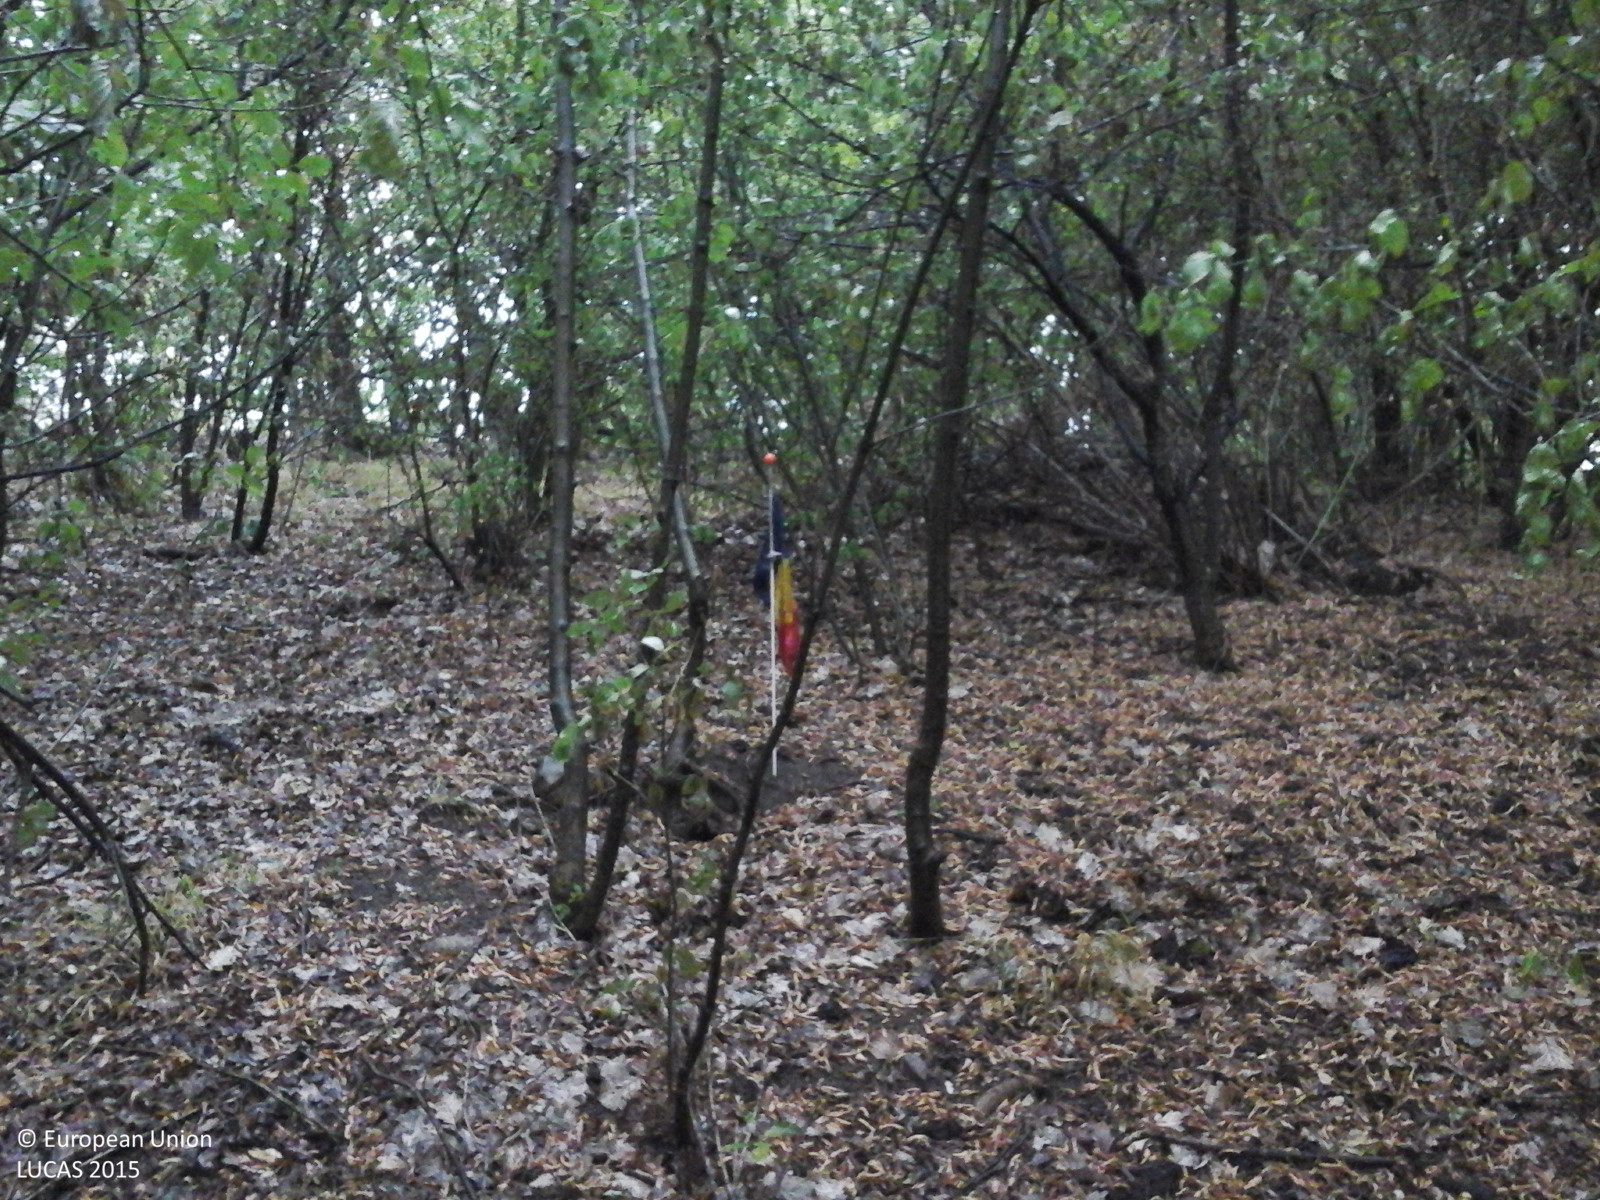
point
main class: Woodland
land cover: Broadleaved woodland
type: mesophytic deciduous forest
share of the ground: > 75 %
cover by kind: broadleaved forest trees 100 %
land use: Forestry
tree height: > 5 m
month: August
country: RO
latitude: 44.7152
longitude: 22.7041
